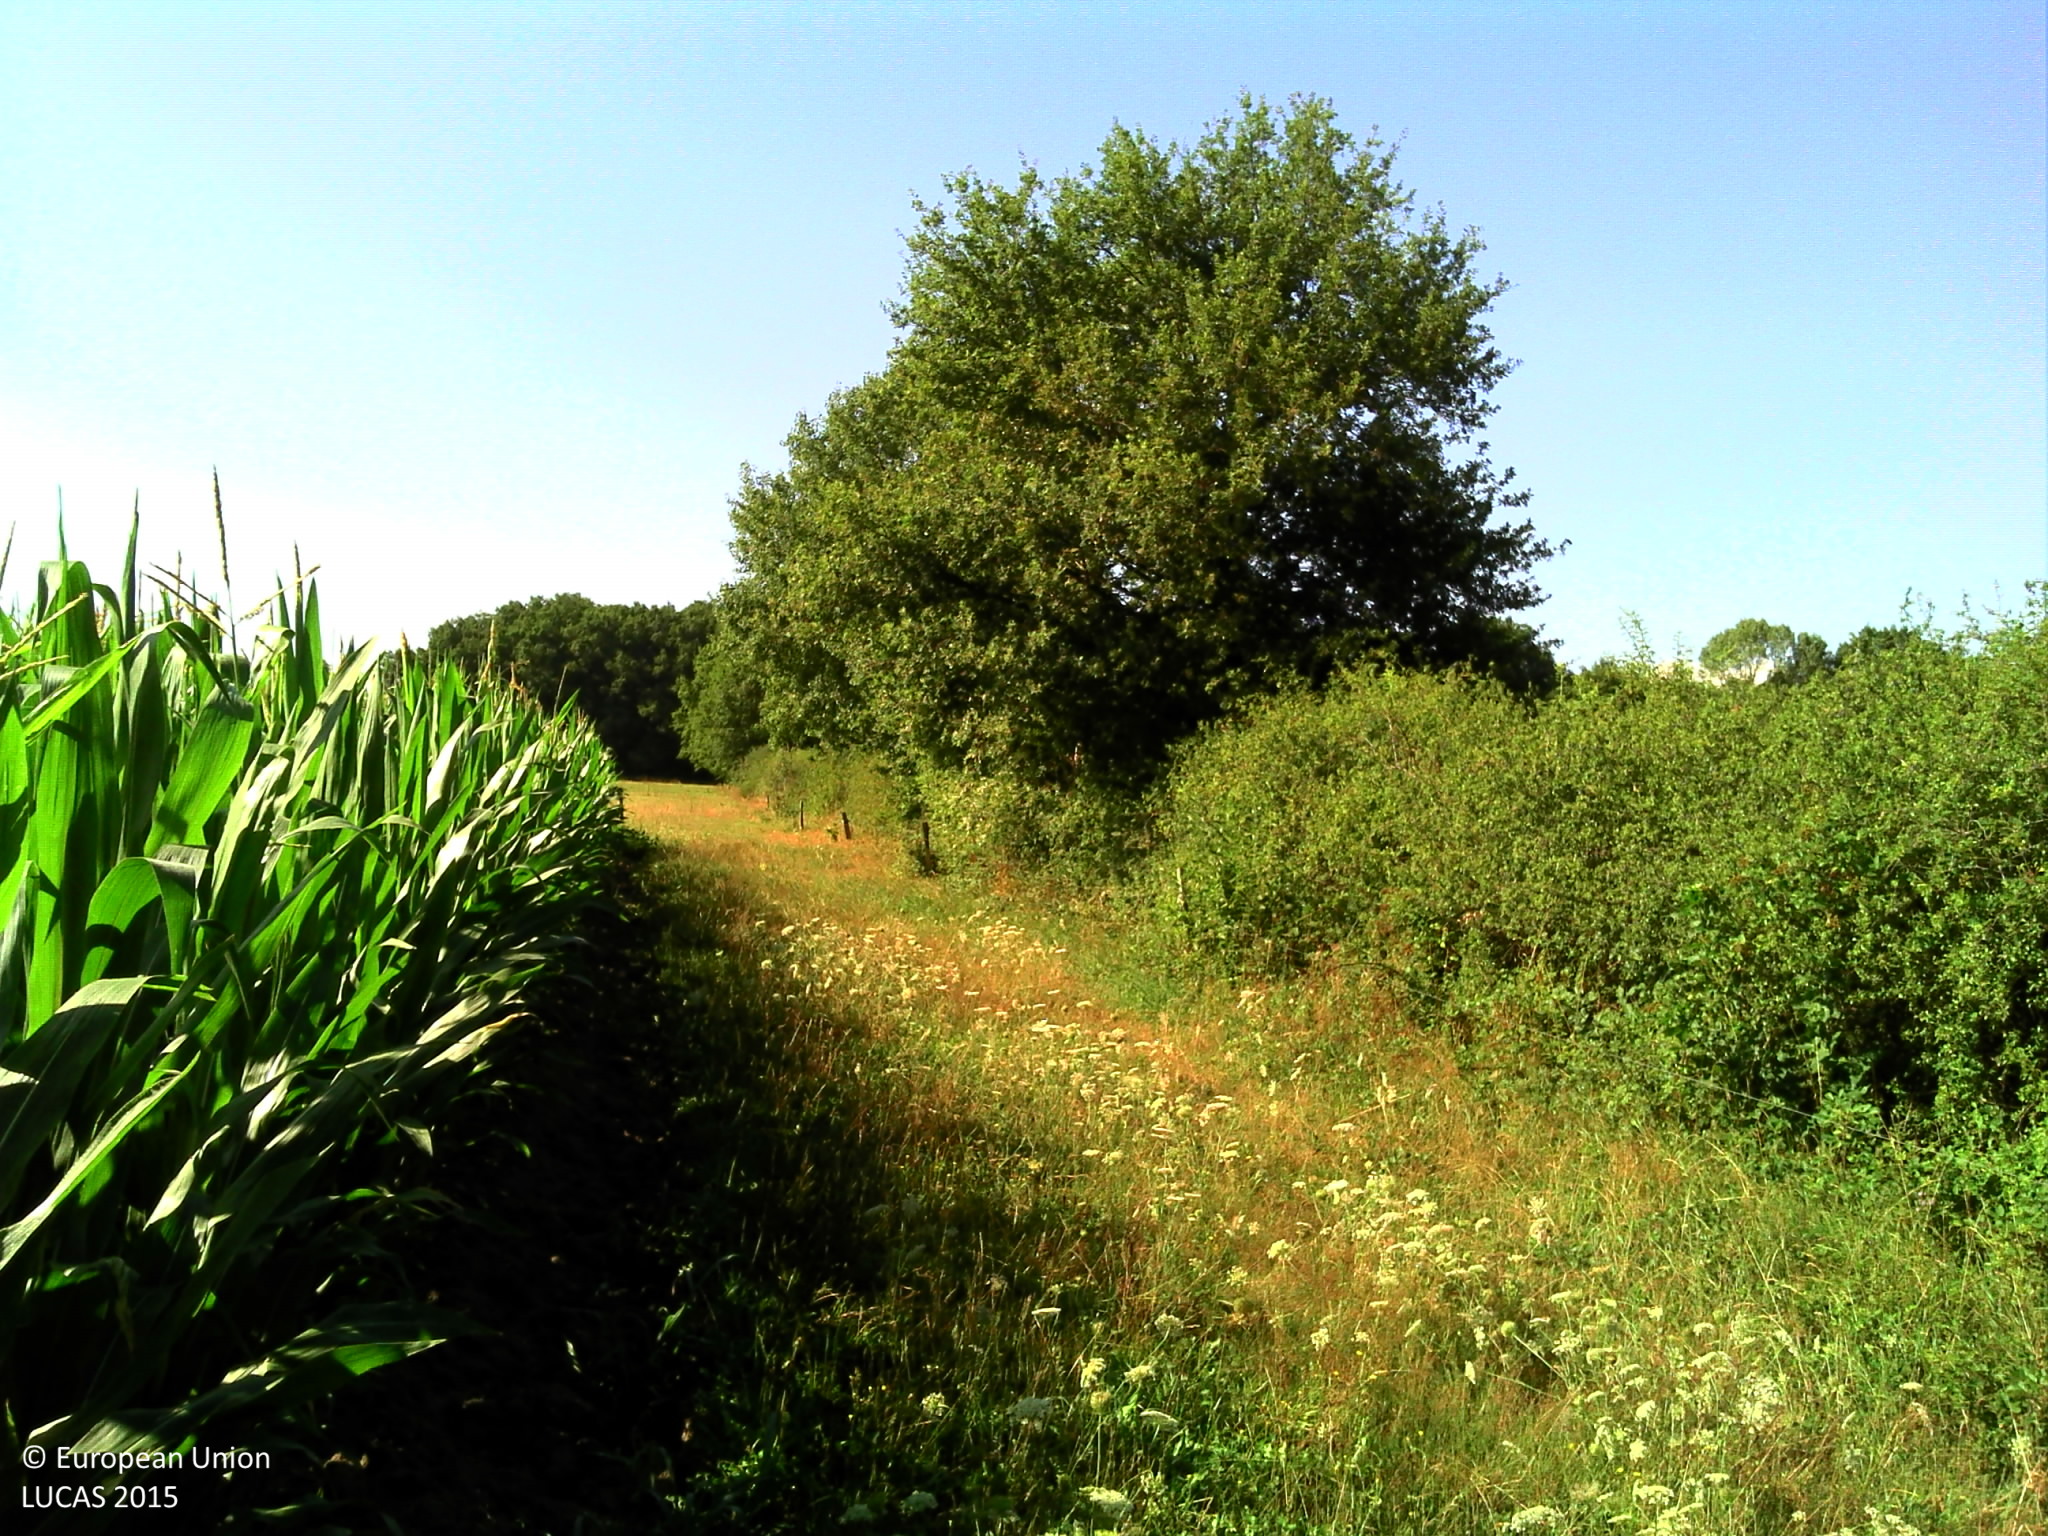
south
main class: Cropland
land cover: Maize
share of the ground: > 75 %
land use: Agriculture (excluding fallow land and kitchen gardens)
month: July
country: FR
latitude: 45.7550
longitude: 4.1016
